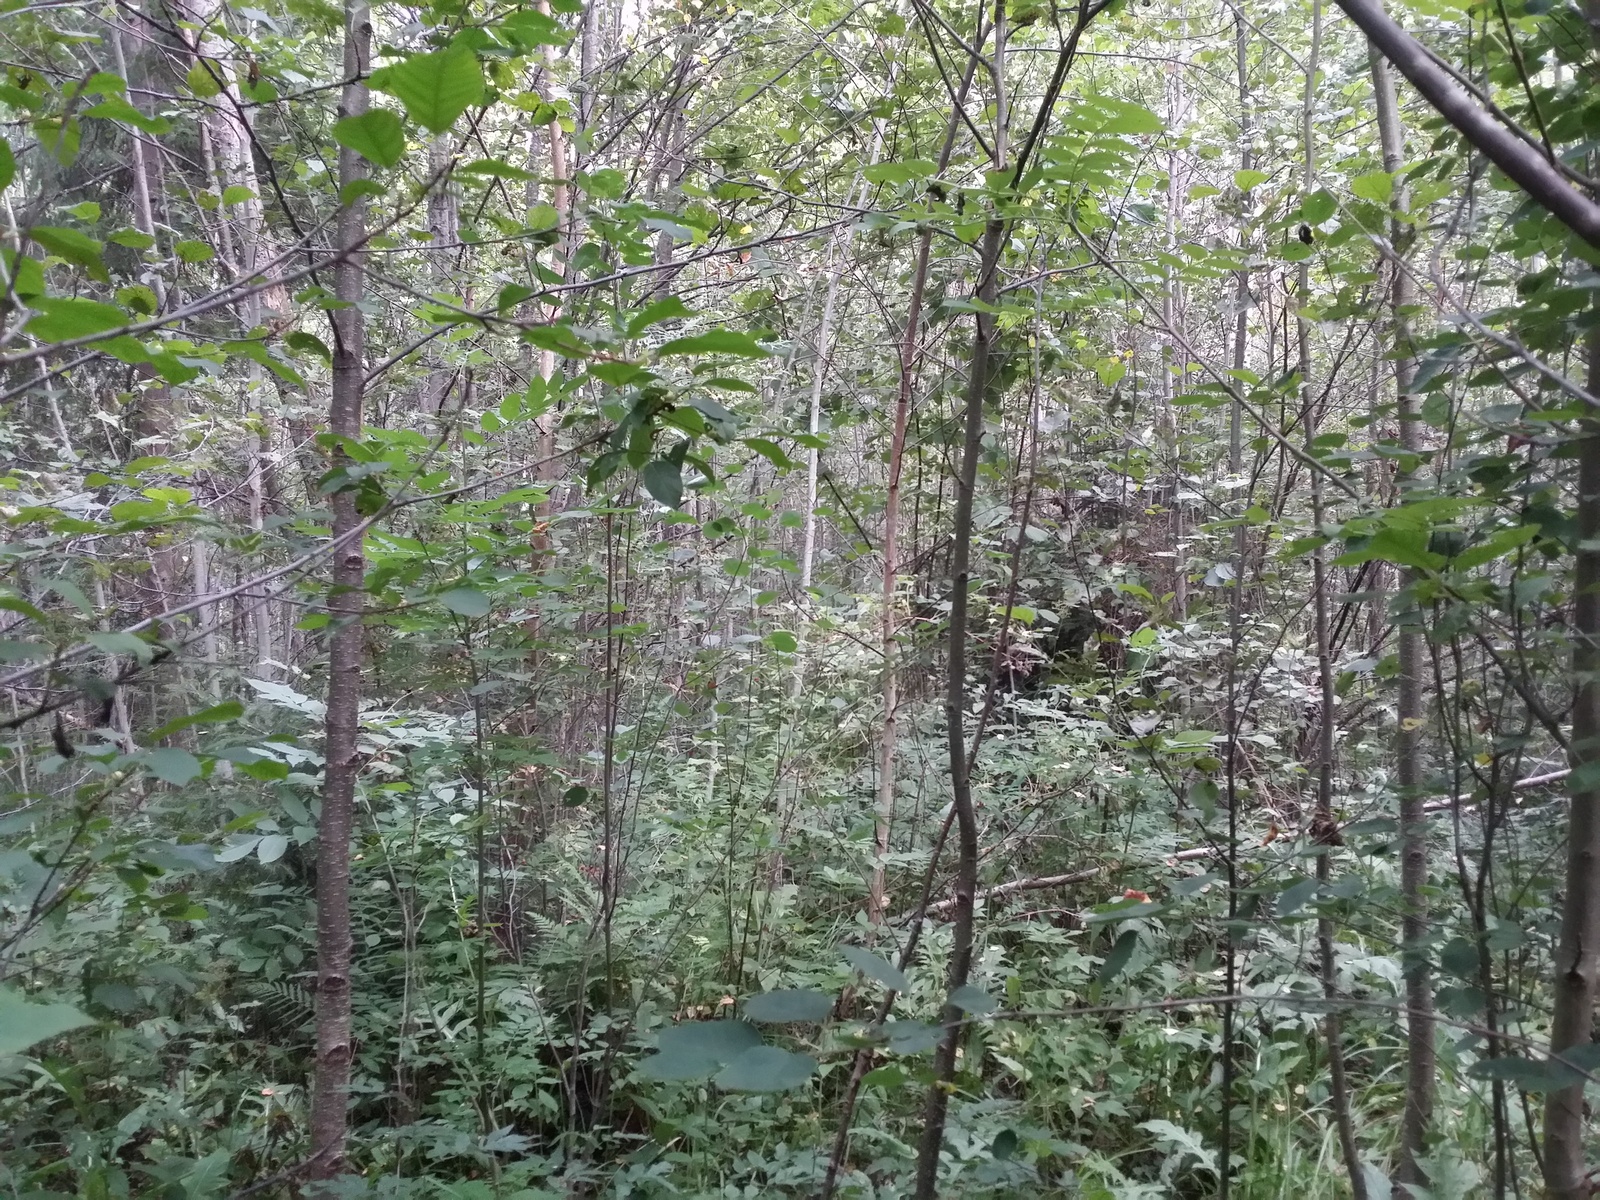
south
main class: Woodland
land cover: Broadleaved woodland
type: non-riverine alder, birch or aspen forest
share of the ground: > 75 %
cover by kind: broadleaved forest trees 85 %, herbaceous plants 10 %, shrubs 5 %
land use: Forestry
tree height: > 5 m
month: August
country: LV
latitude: 56.9560
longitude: 27.1515
